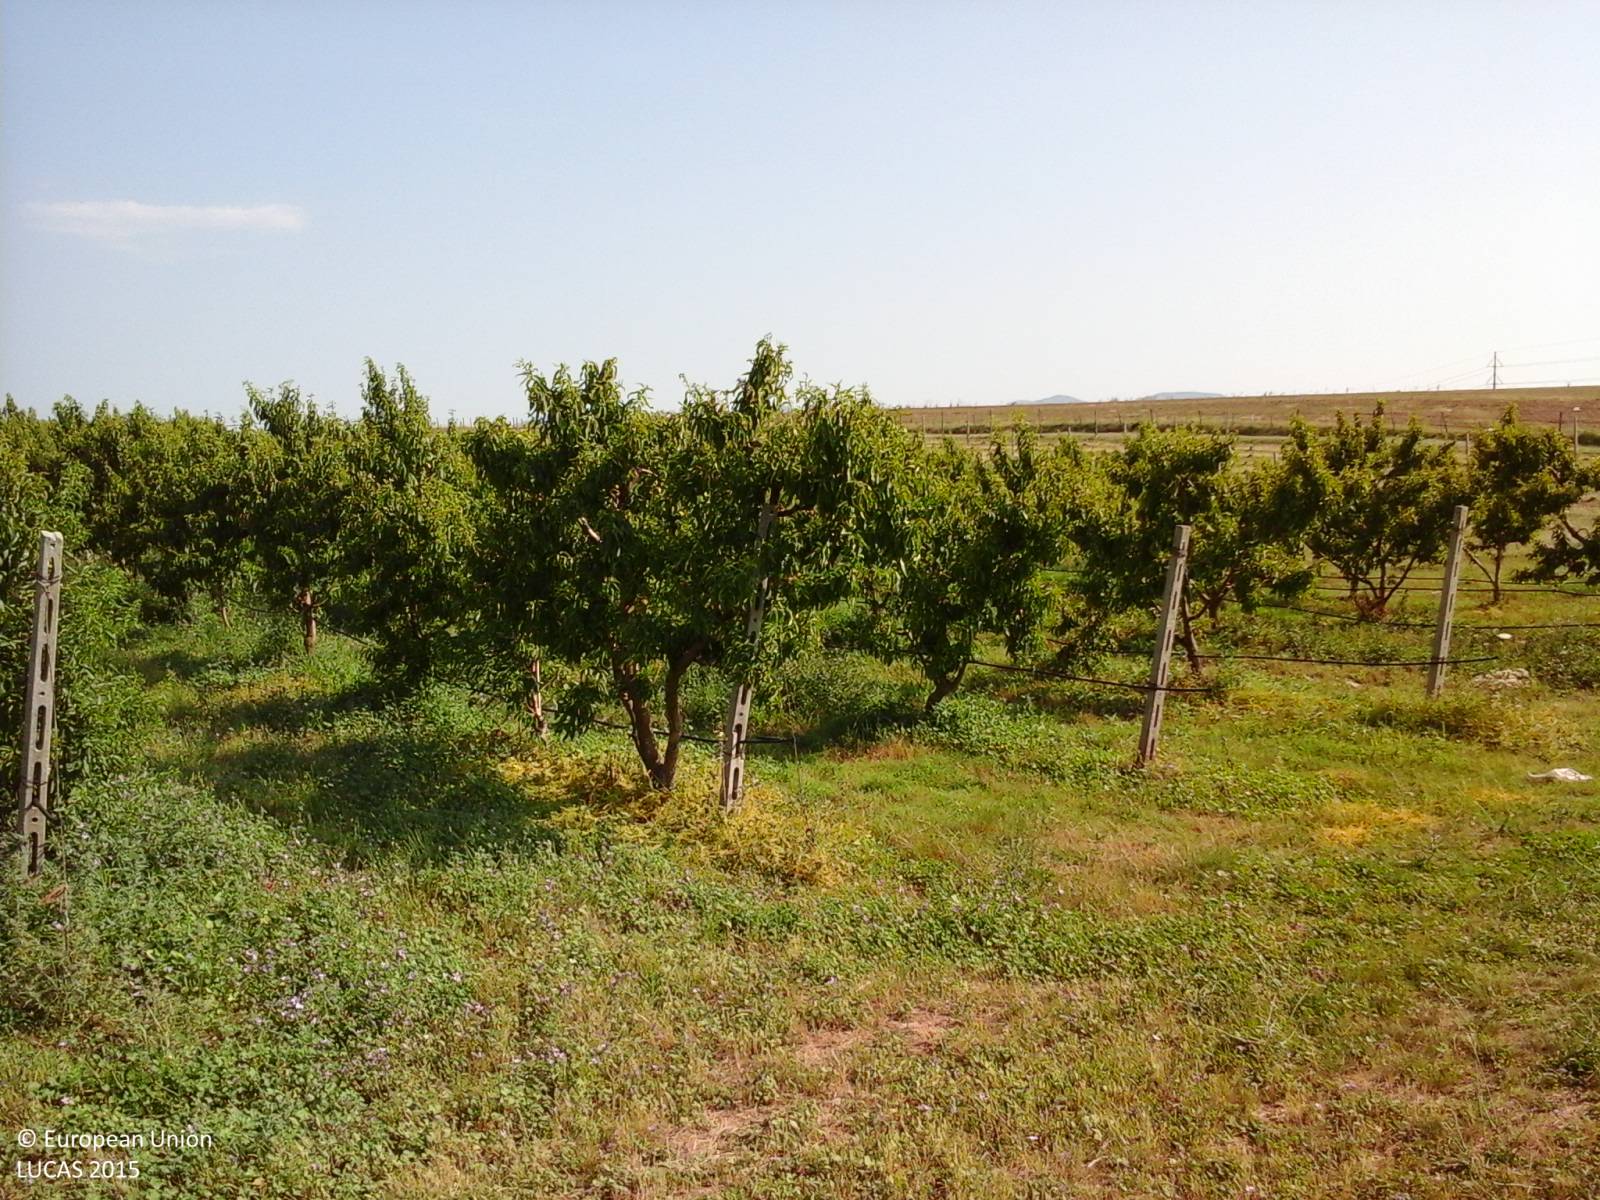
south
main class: Cropland
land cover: Other fruit trees and berries
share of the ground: > 75 %
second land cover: Spontaneously vegetated surfaces
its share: 50 - 75 %
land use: Agriculture (excluding fallow land and kitchen gardens)
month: July
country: IT
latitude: 41.9117
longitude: 12.7507
